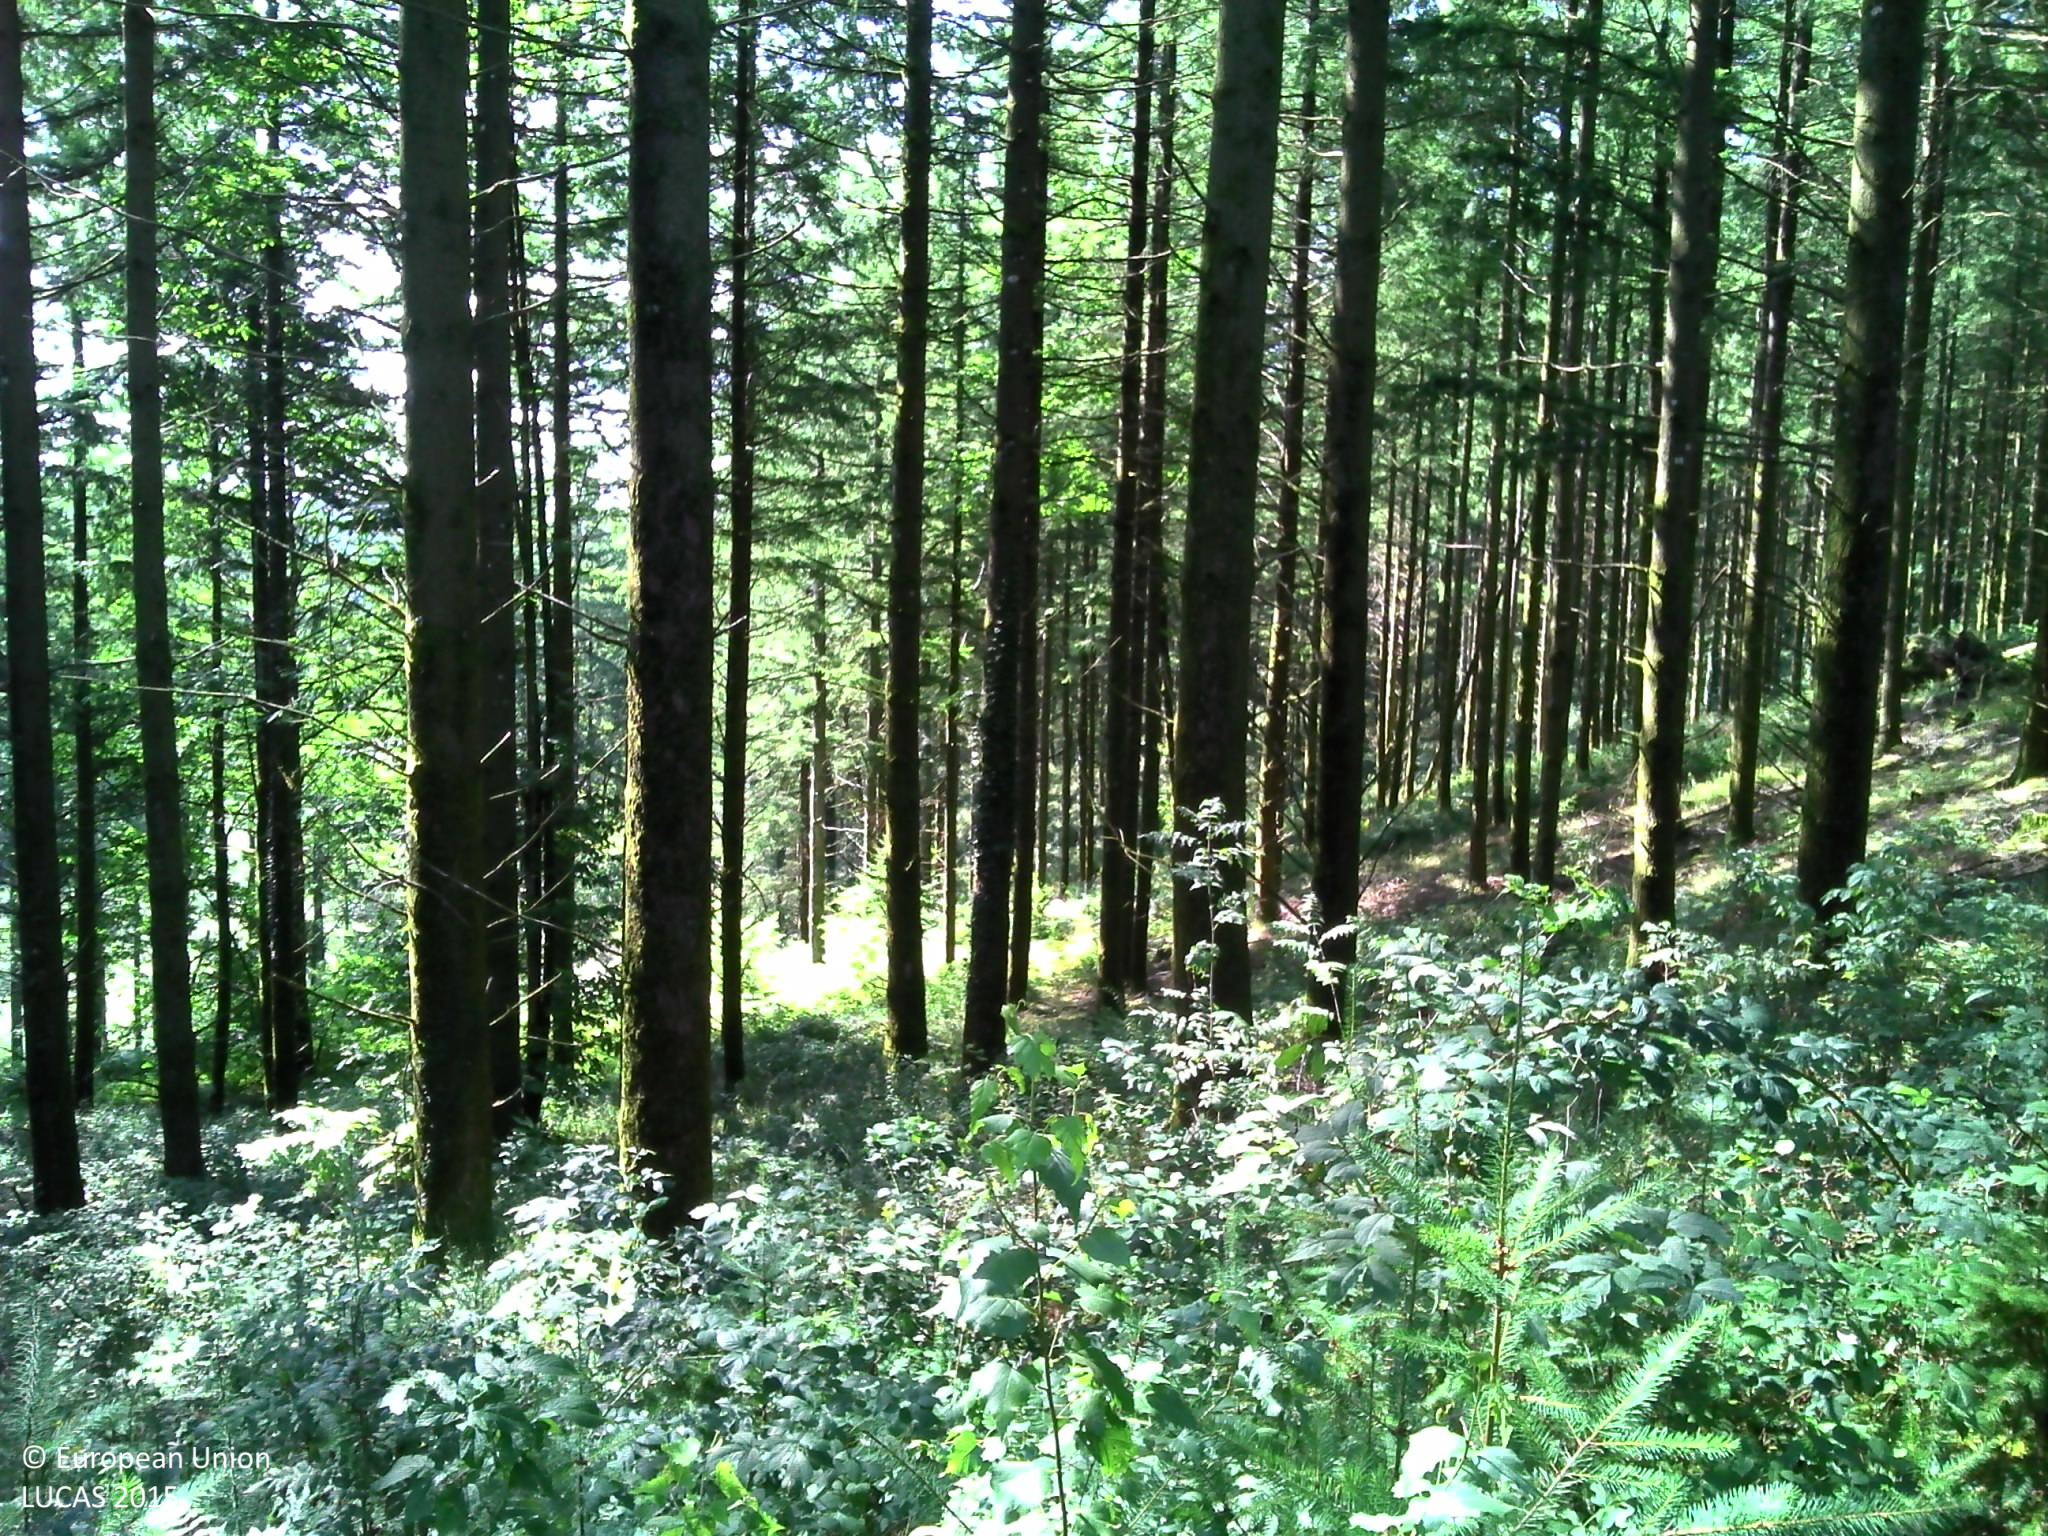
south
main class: Woodland
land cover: Other coniferous woodland
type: exotic forest
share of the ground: > 75 %
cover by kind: coniferous forest trees 65 %, herbaceous plants 35 %
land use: Forestry
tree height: > 5 m
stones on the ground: < 10 %
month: August
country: FR
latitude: 45.6554
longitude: 1.7943
